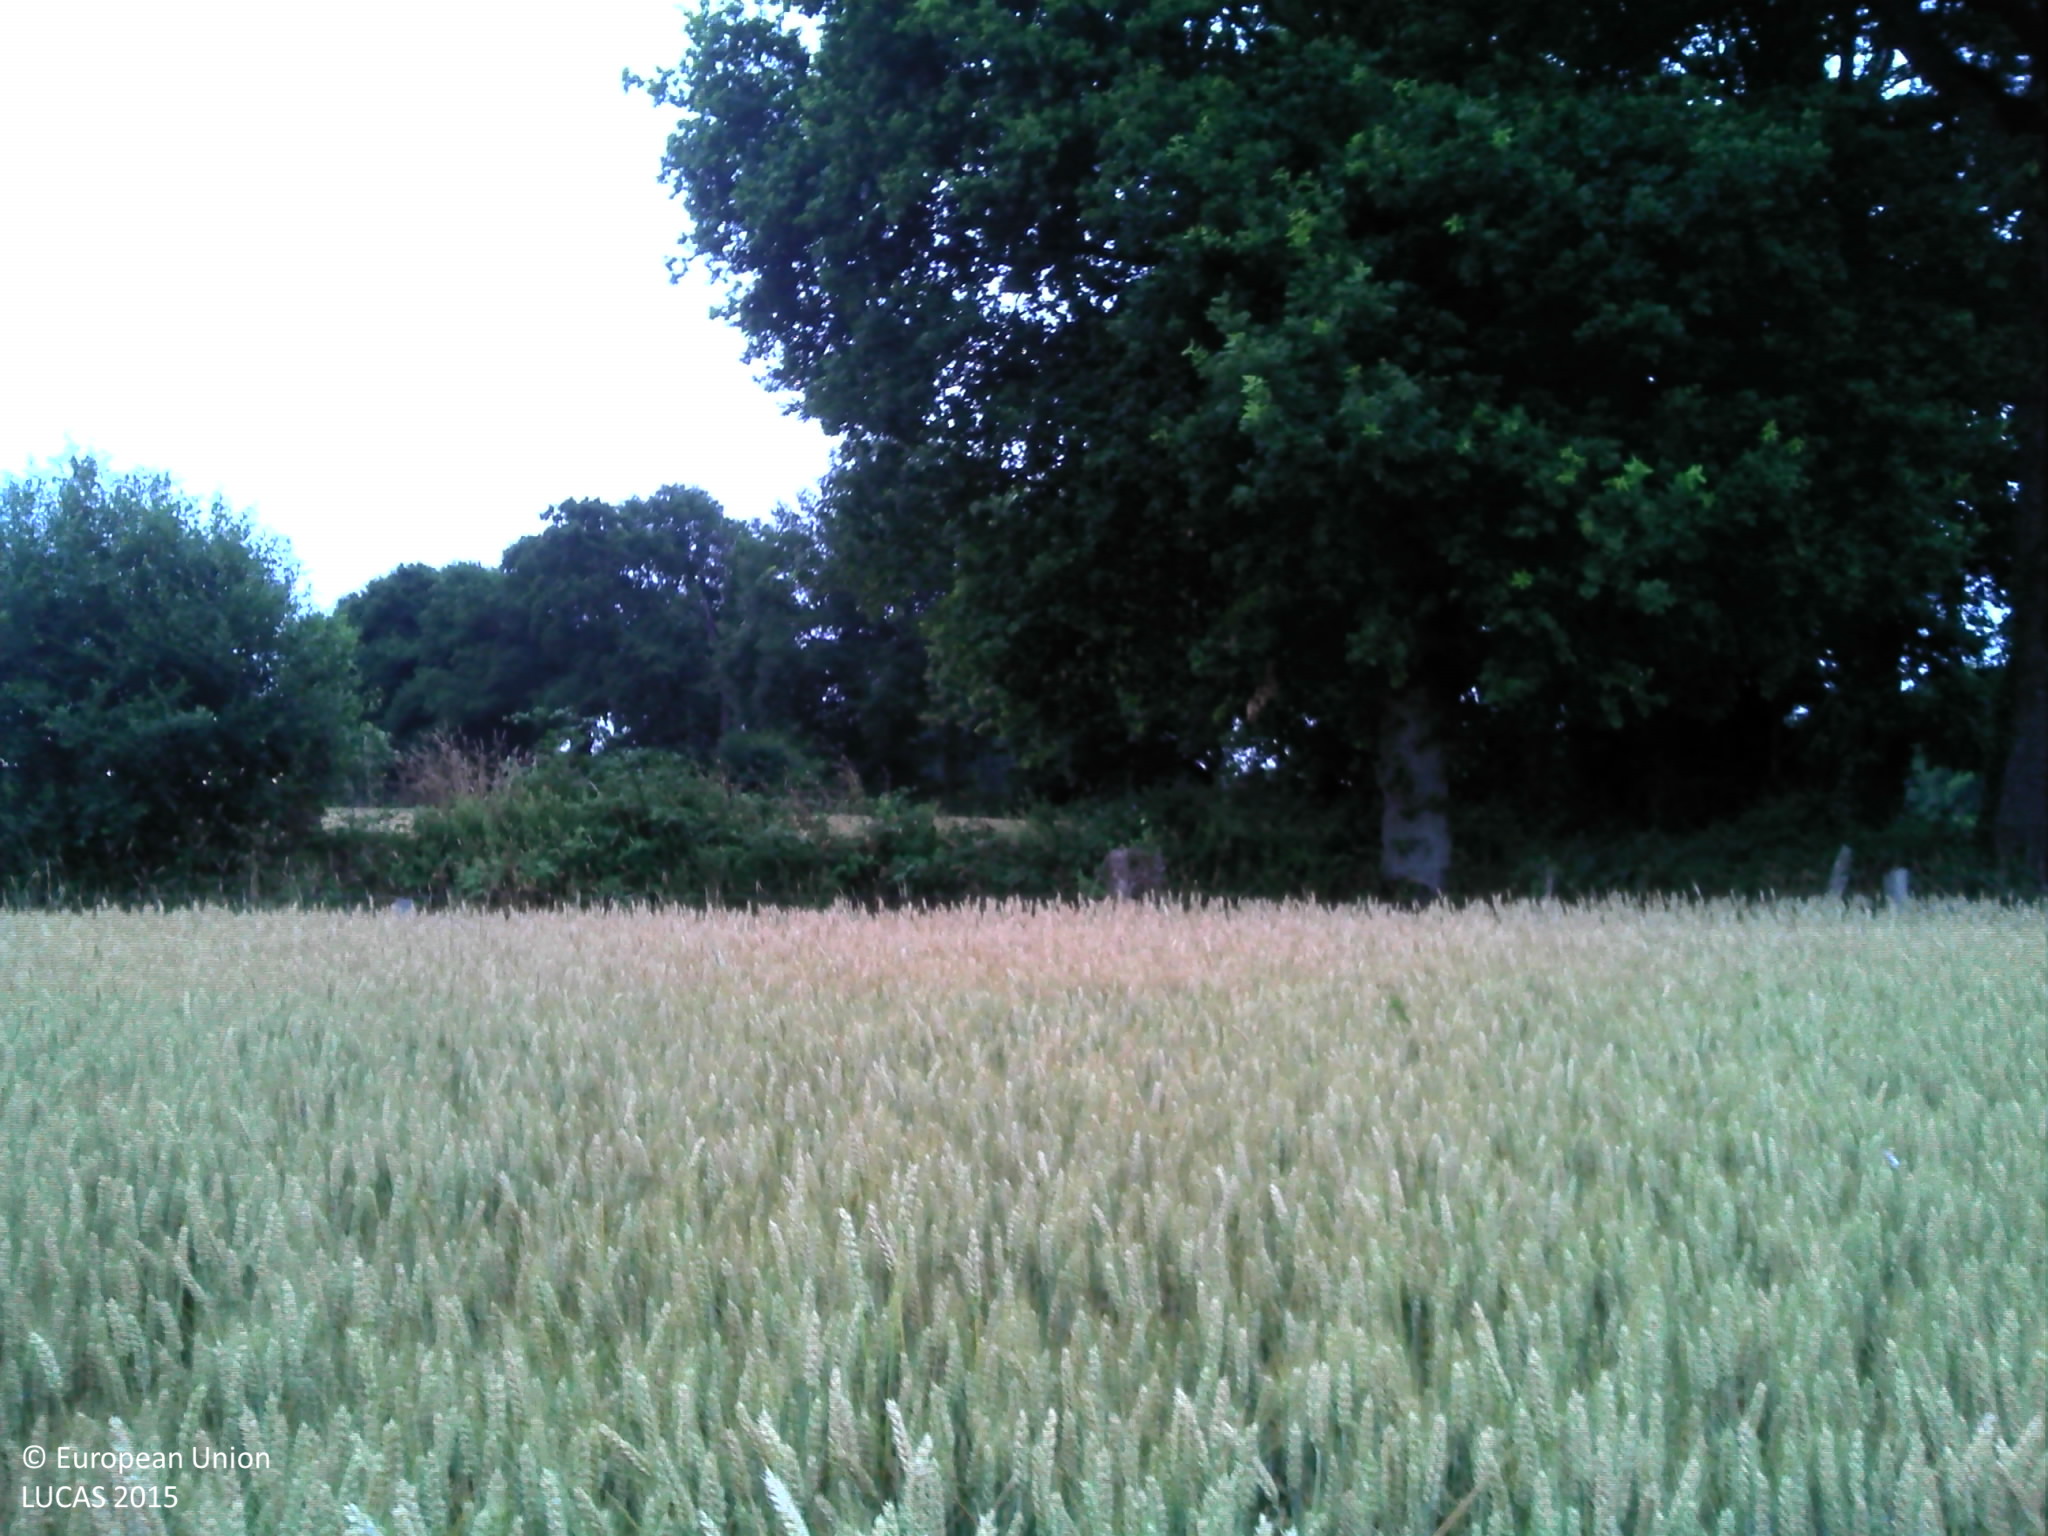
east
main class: Cropland
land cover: Common wheat
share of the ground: > 75 %
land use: Agriculture (excluding fallow land and kitchen gardens)
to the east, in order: Common wheat; Fences; Tracks; Abandoned hedges; Common wheat; Lines of trees; Tracks; Fences; Maize; Fences; Lines of trees
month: July
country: FR
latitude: 48.1966
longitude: -1.7132
